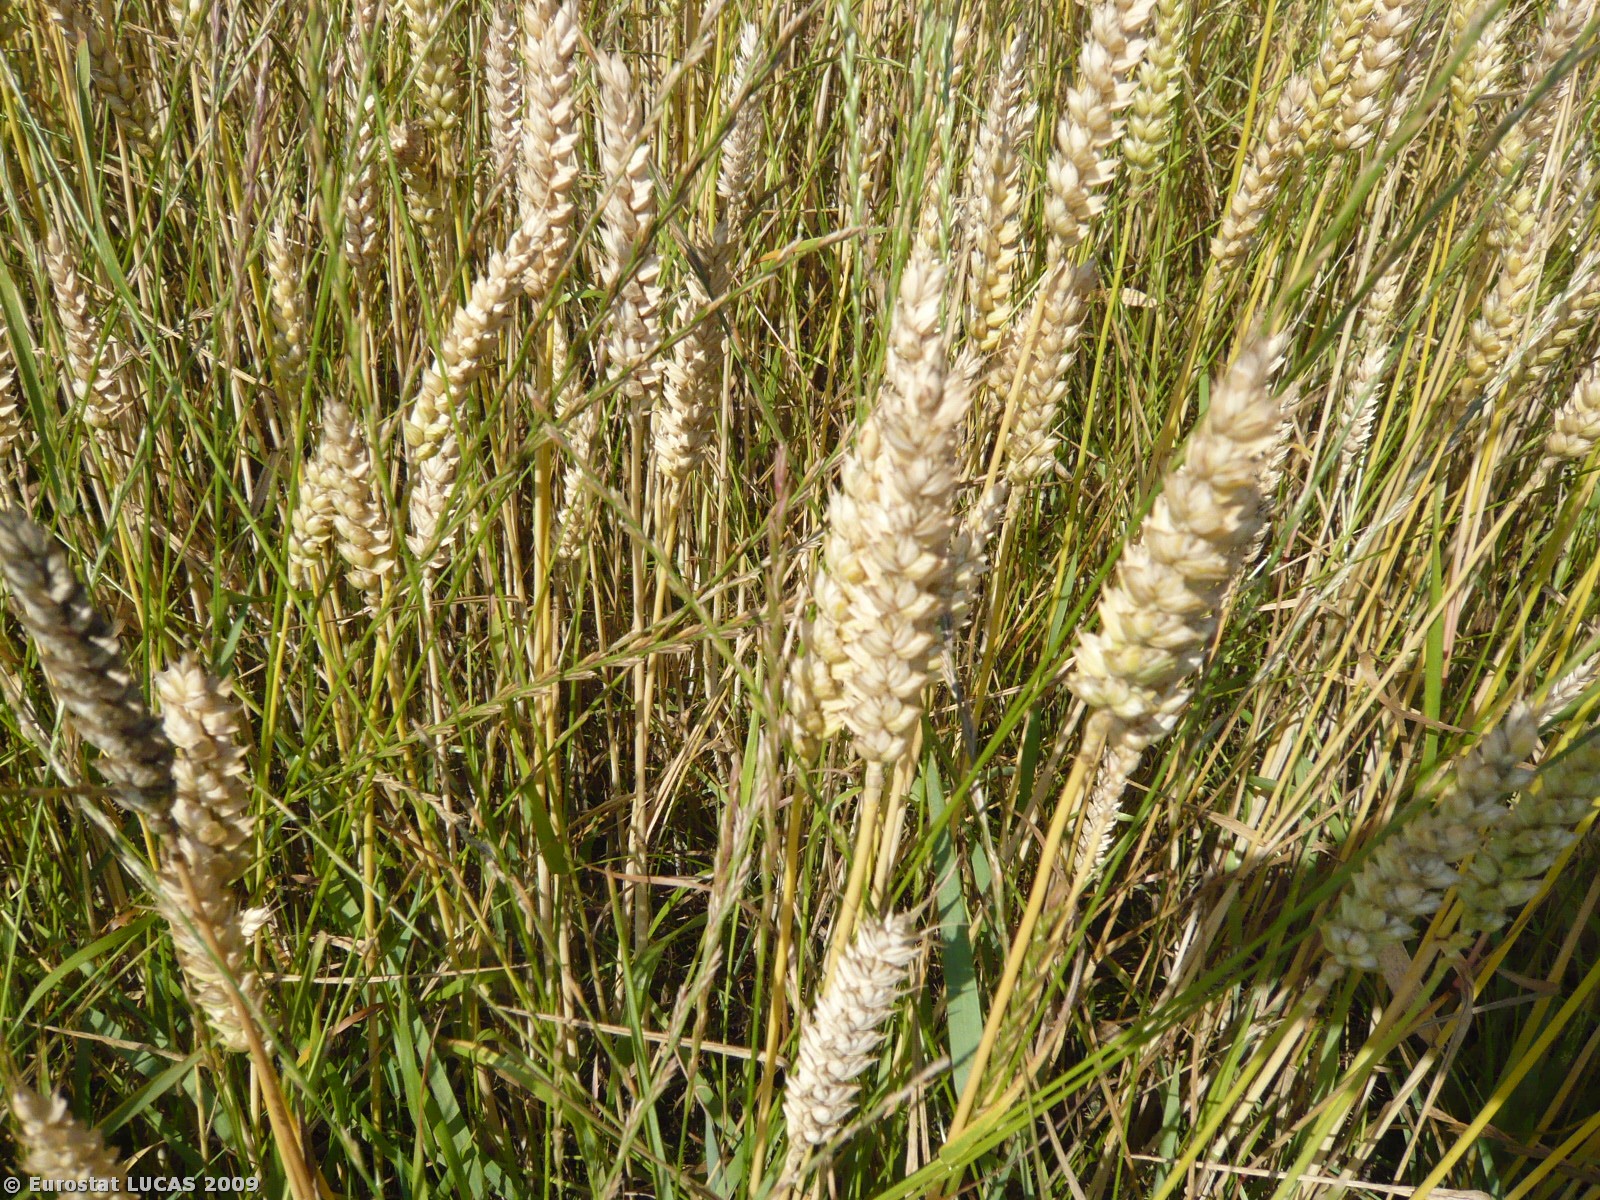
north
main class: Cropland
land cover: Common wheat
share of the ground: > 75 %
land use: Agriculture (excluding fallow land and kitchen gardens)
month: July
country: DK
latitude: 55.5806
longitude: 11.8861
